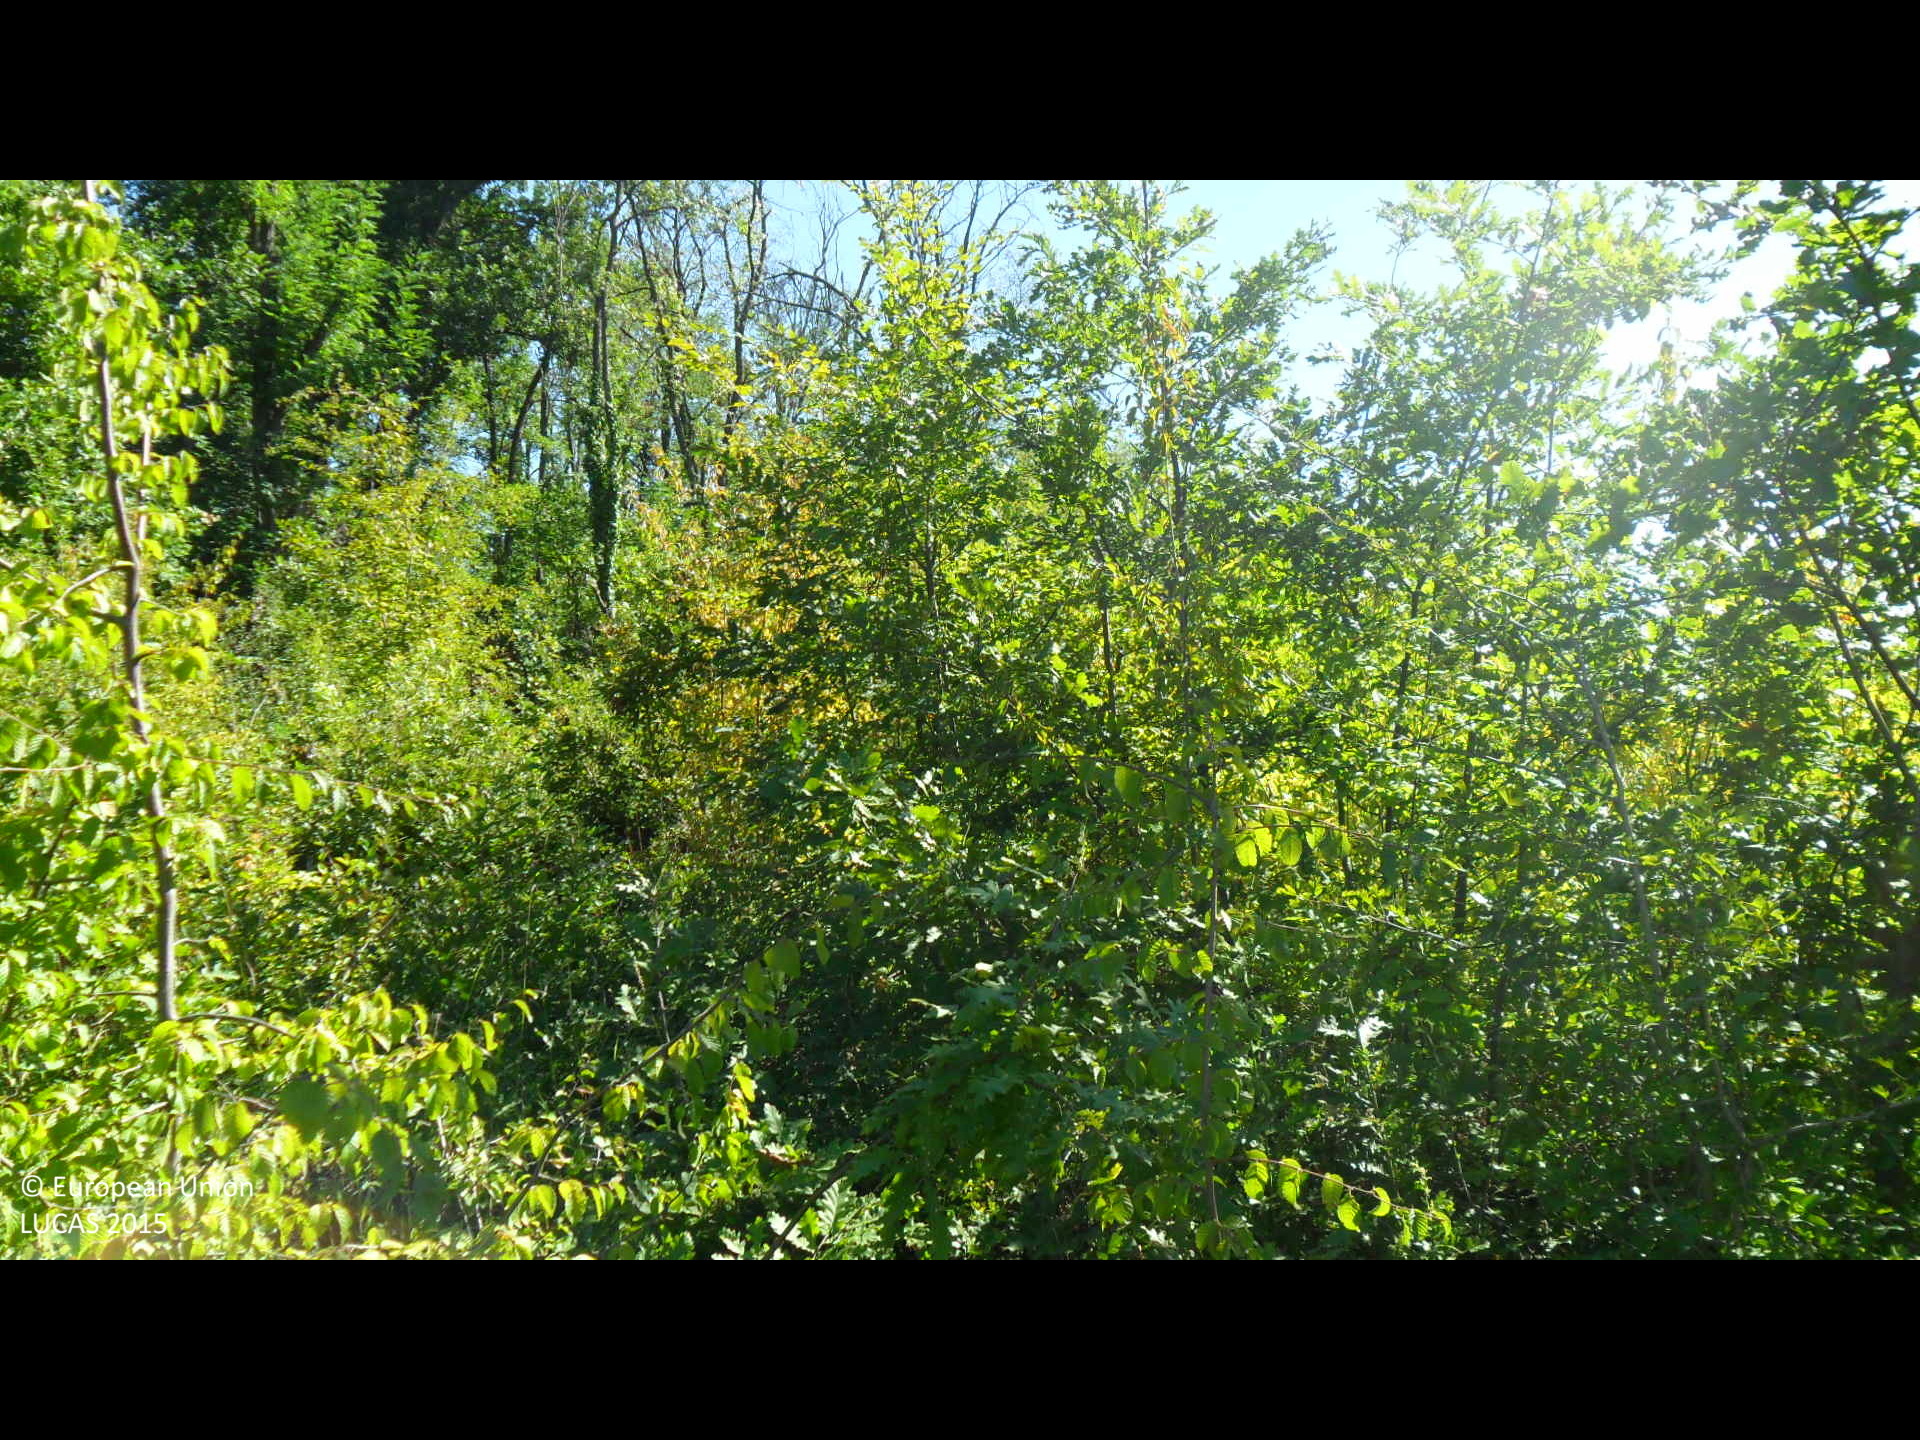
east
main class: Woodland
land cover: Broadleaved woodland
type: thermophilous deciduous forest
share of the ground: > 75 %
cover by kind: broadleaved forest trees 95 %, unconsolidated bare surface 5 %
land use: Forestry
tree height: > 5 m
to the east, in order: Broadleaved woodland
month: September
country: BG
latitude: 43.1625
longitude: 26.2937
